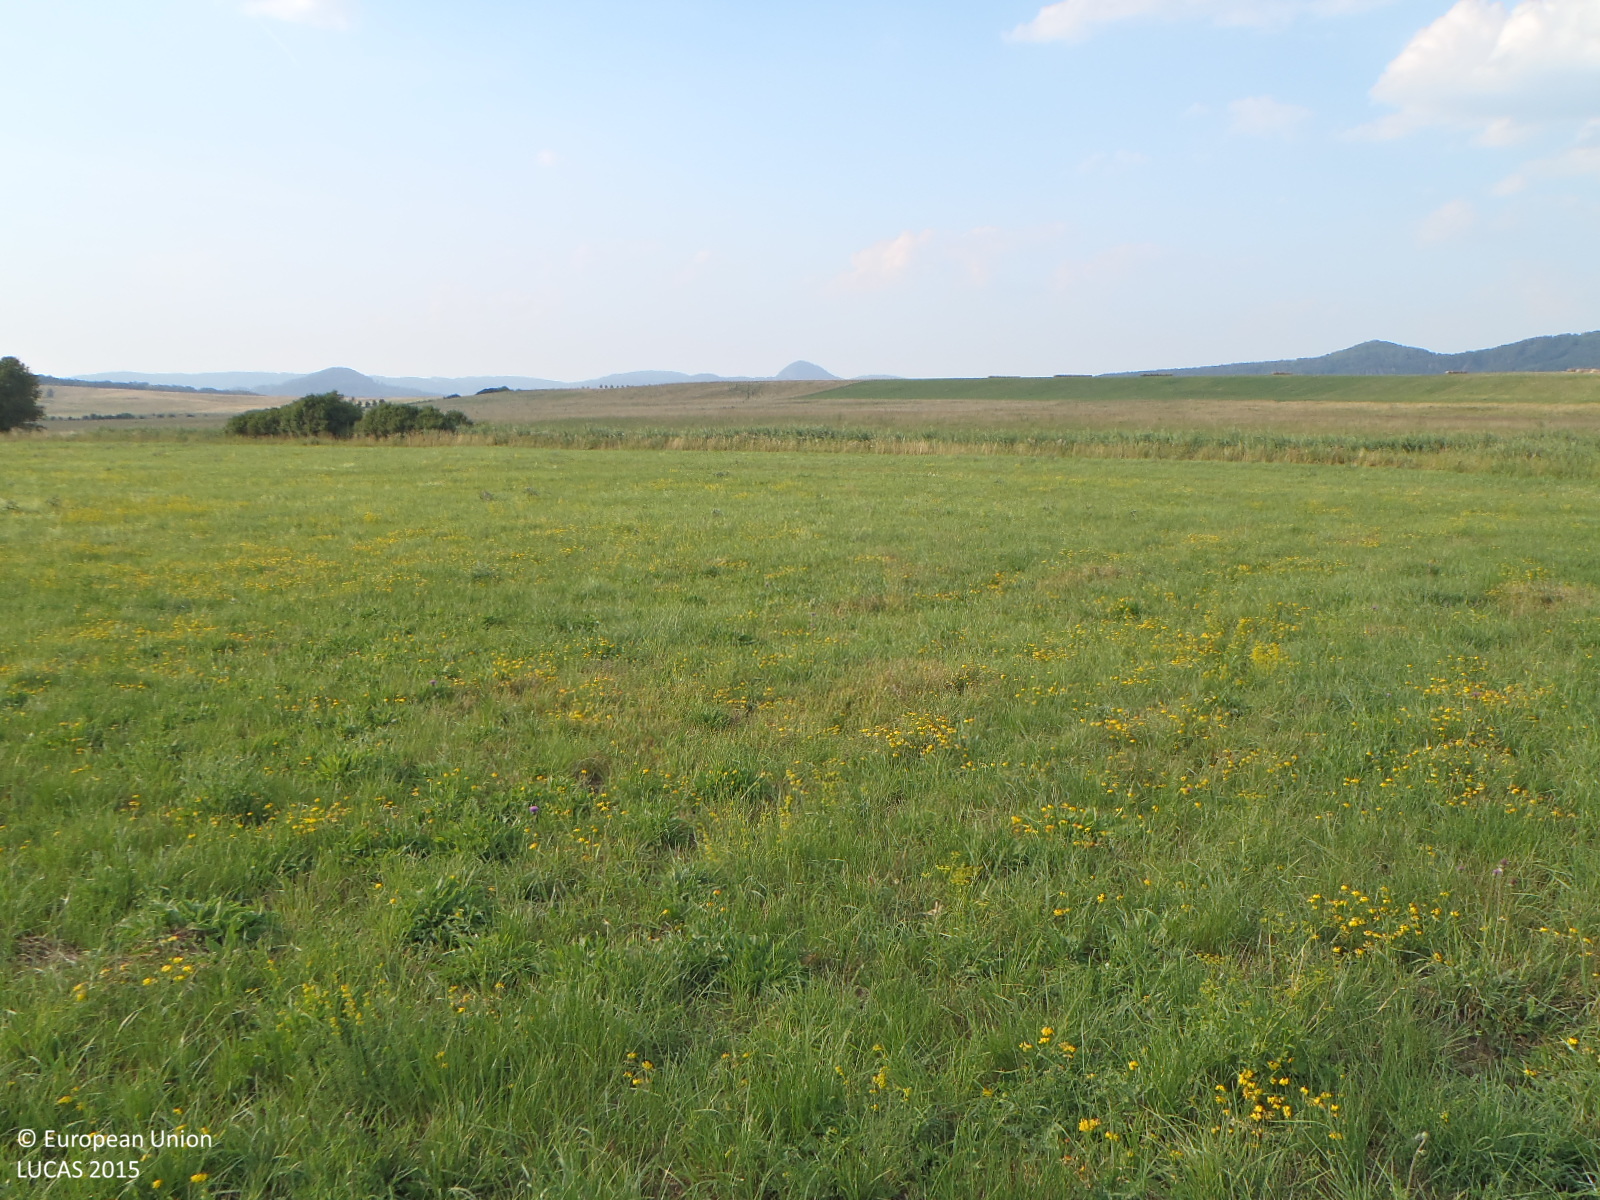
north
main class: Grassland
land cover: Grassland without tree/shrub cover
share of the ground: > 75 %
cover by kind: herbaceous plants 100 %
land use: Agriculture (excluding fallow land and kitchen gardens)
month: August
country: CZ
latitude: 50.6868
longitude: 14.5738
